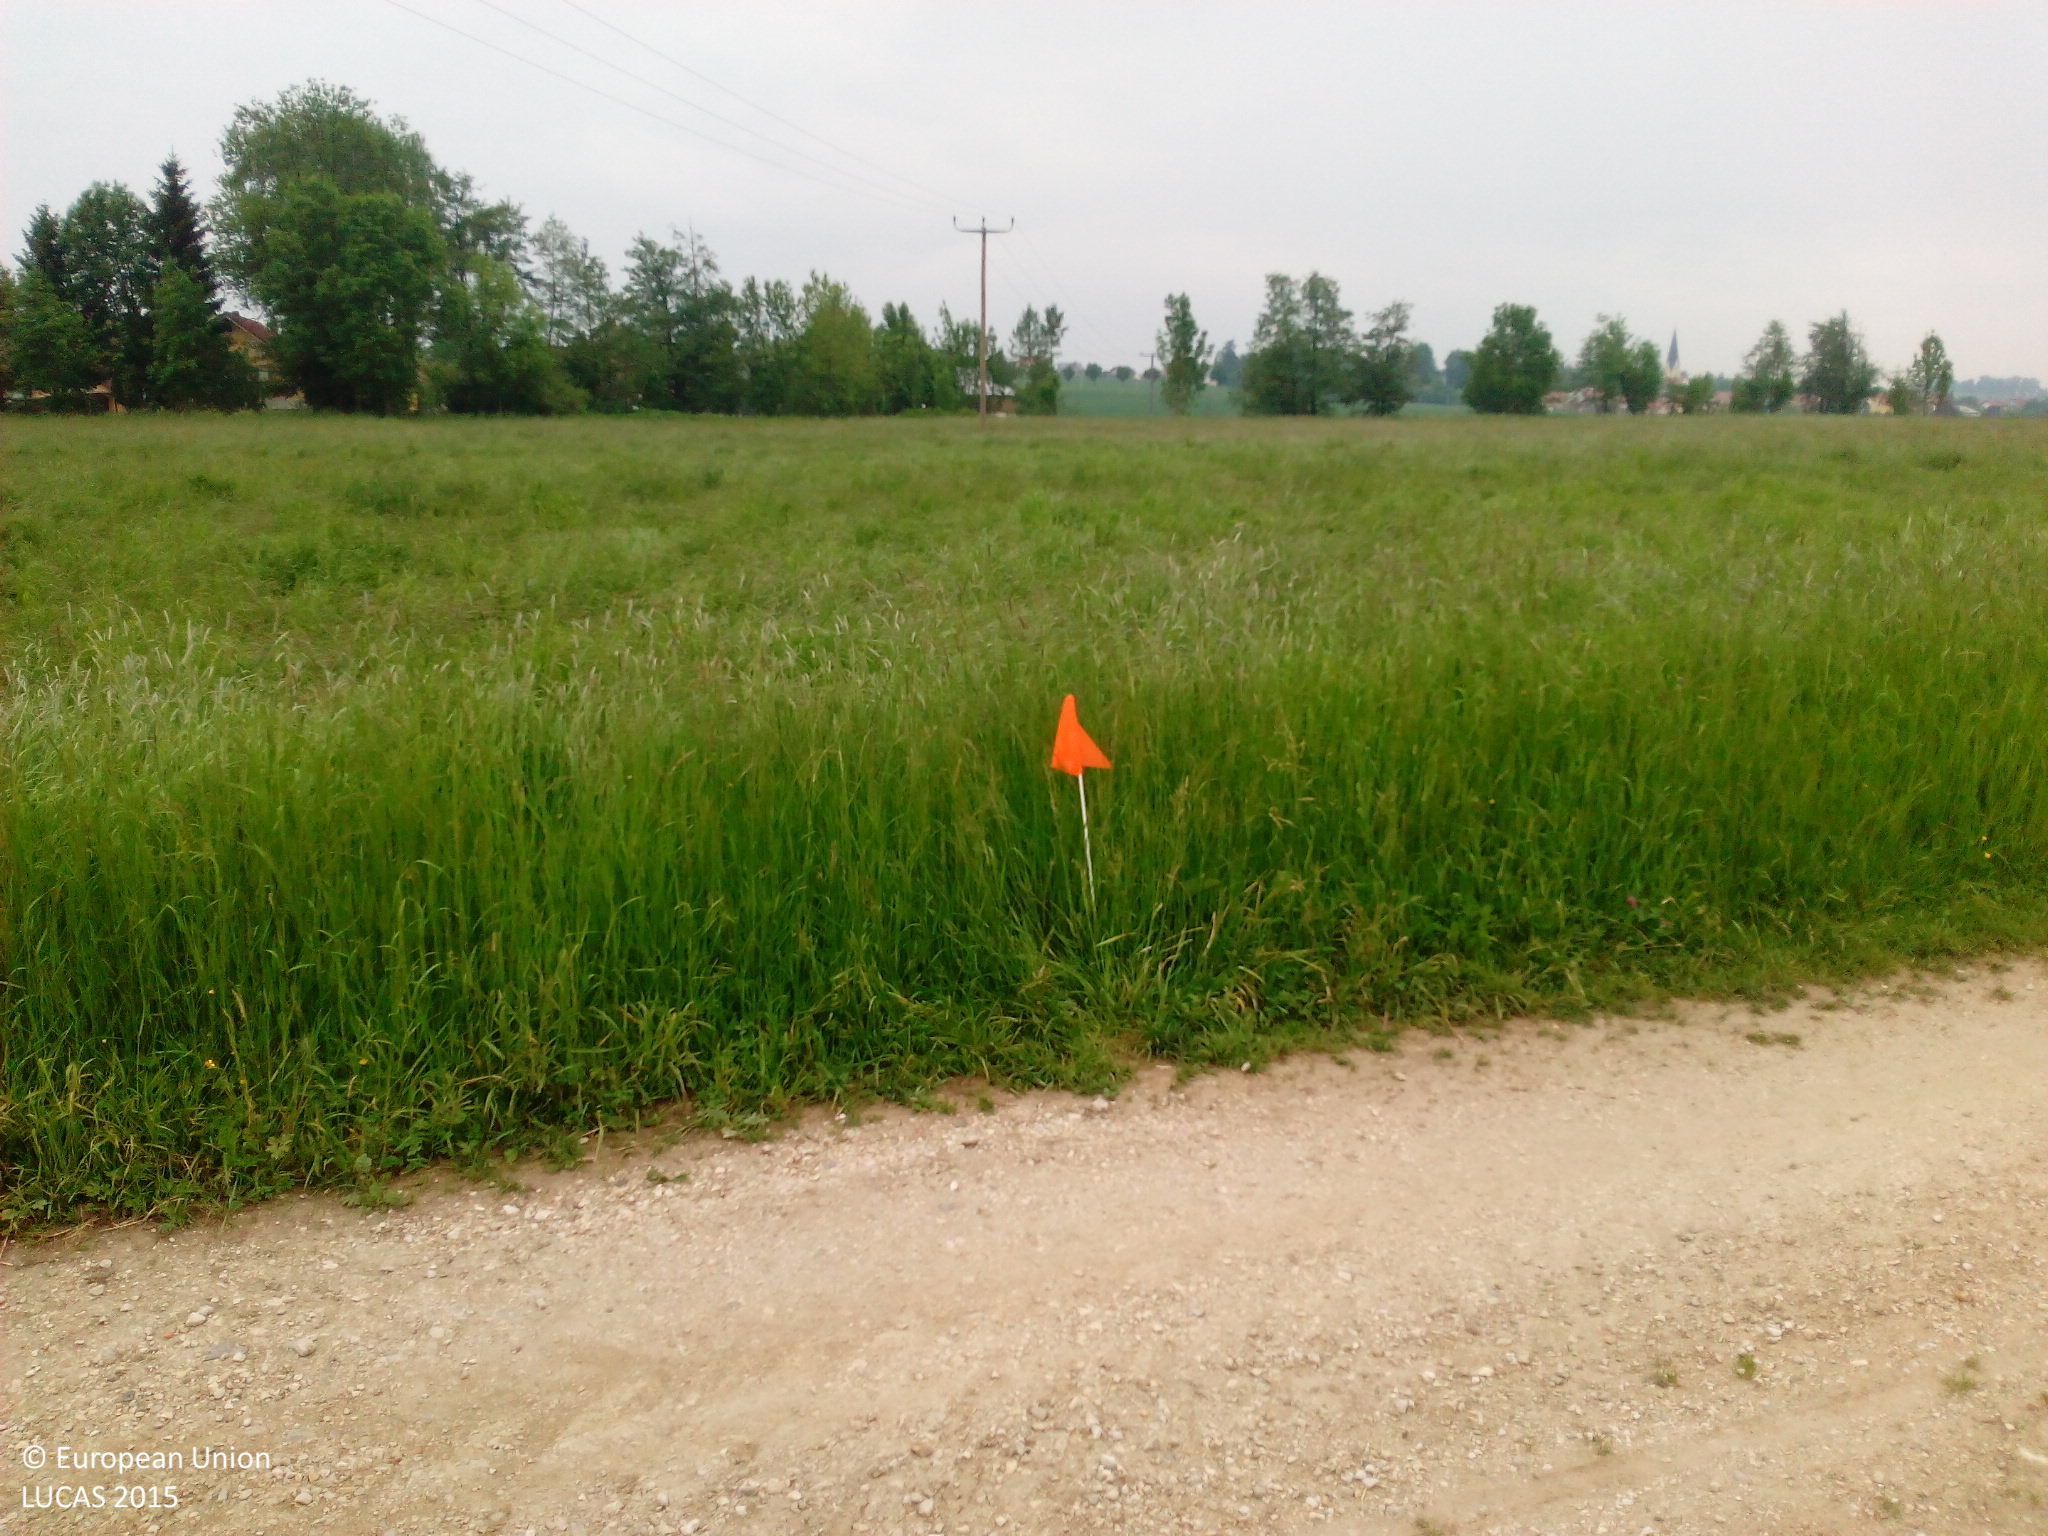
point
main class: Grassland
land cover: Grassland without tree/shrub cover
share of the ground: > 75 %
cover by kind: herbaceous plants 100 %
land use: Agriculture (excluding fallow land and kitchen gardens)
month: May
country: DE
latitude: 48.8492
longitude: 12.2206
